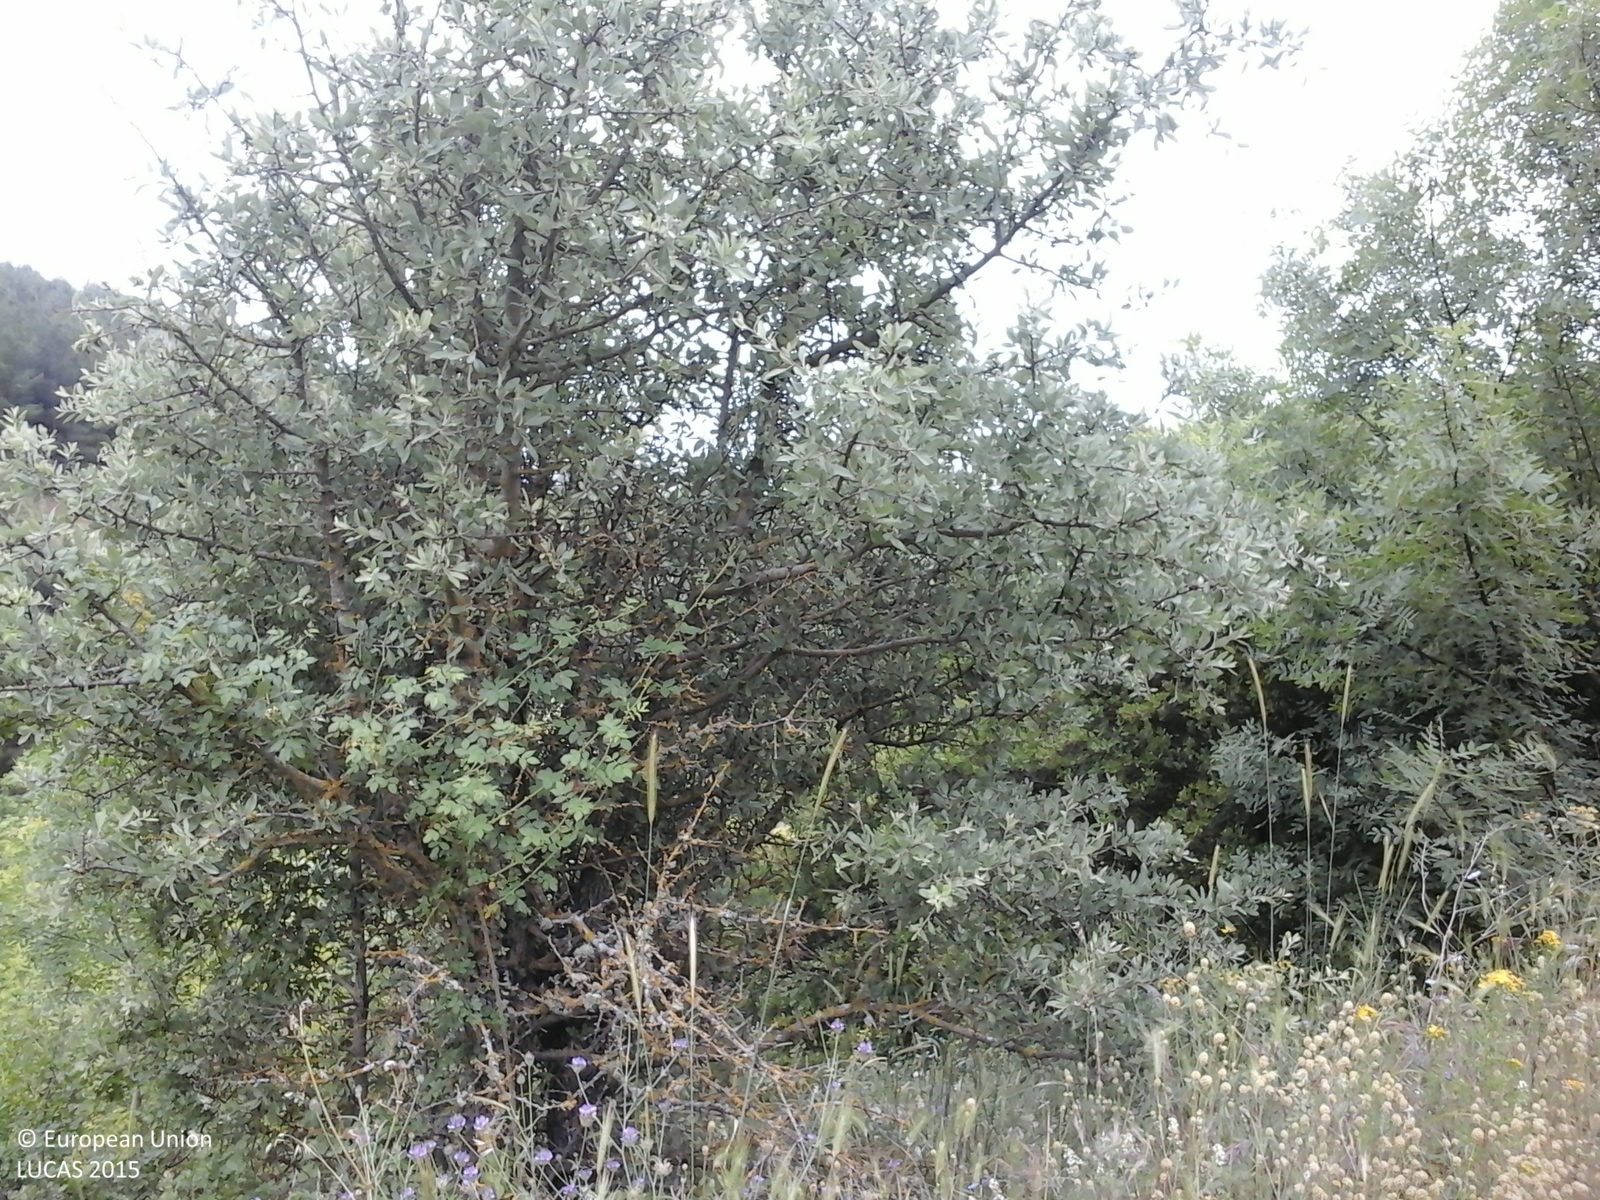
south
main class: Shrubland
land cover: Shrubland without tree cover
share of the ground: > 75 %
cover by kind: shrubs 95 %, herbaceous plants 5 %
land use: Semi-natural and natural areas not in use
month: May
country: GR
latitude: 40.7403
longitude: 22.9519
